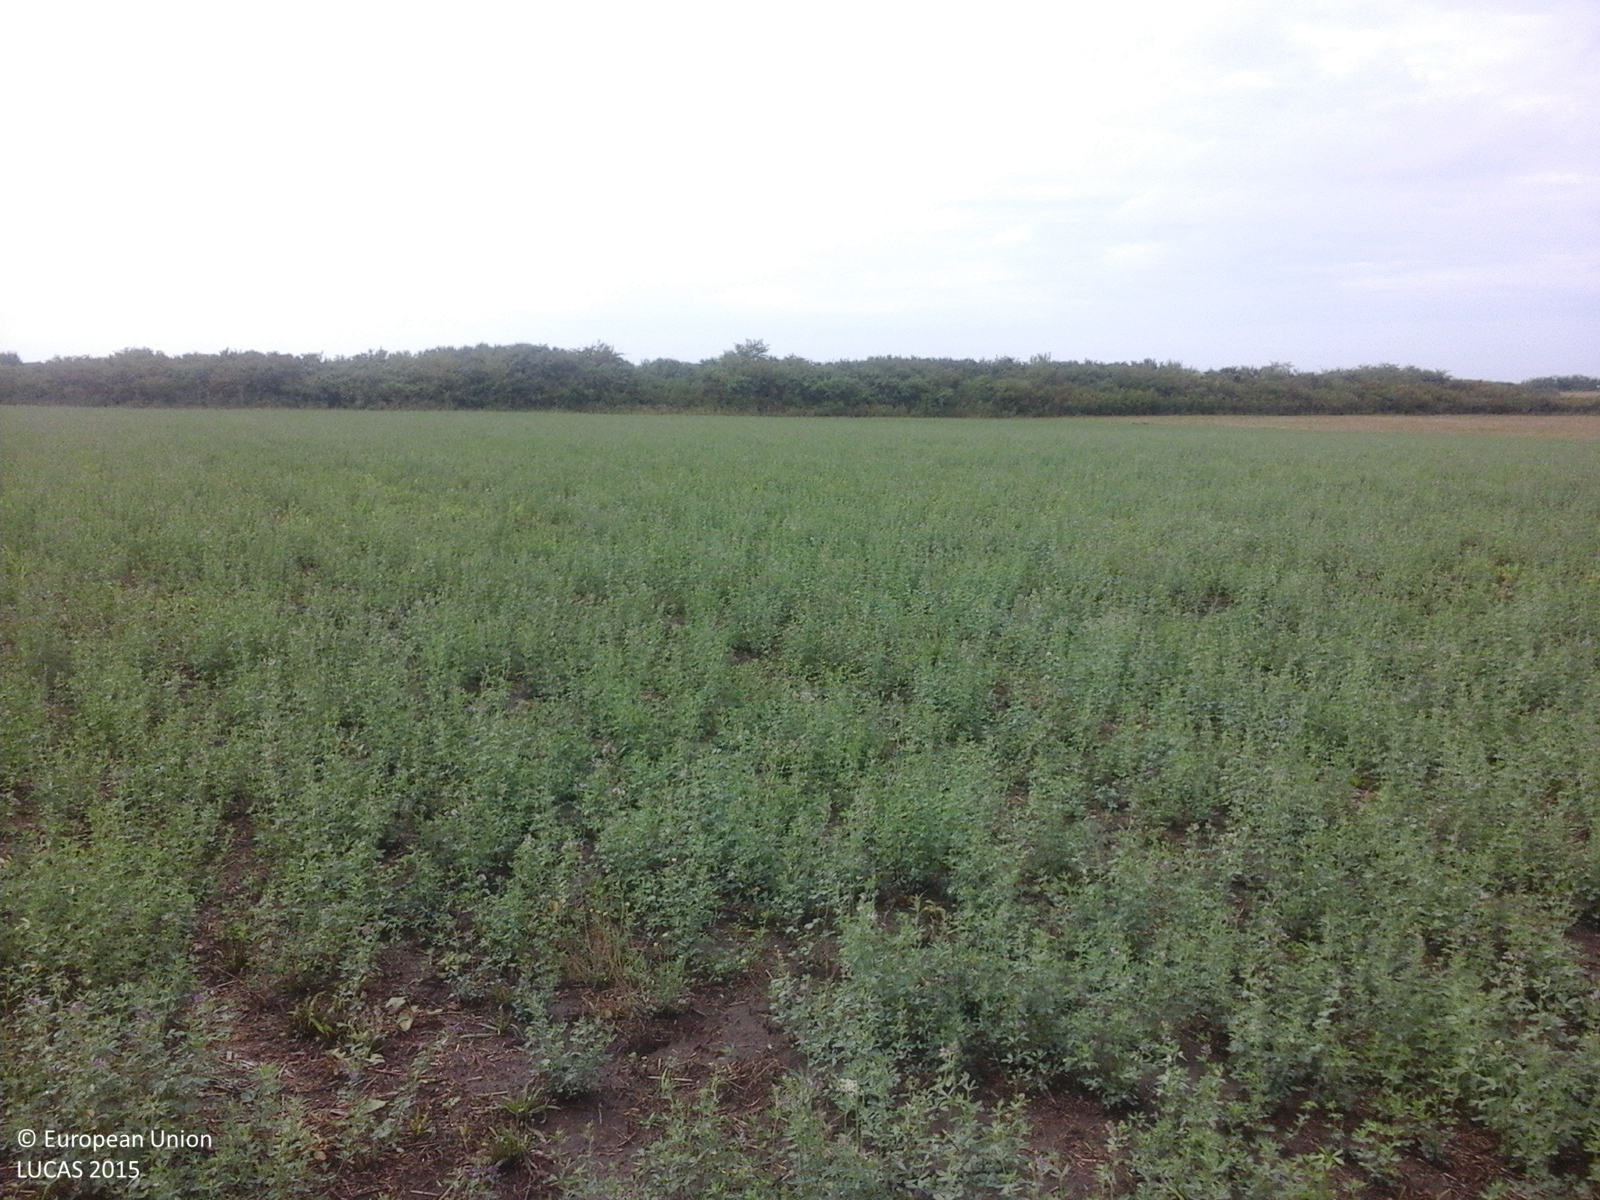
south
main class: Cropland
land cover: Lucerne
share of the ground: > 75 %
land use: Agriculture (excluding fallow land and kitchen gardens)
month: August
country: RO
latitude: 45.5364
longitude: 21.2605
